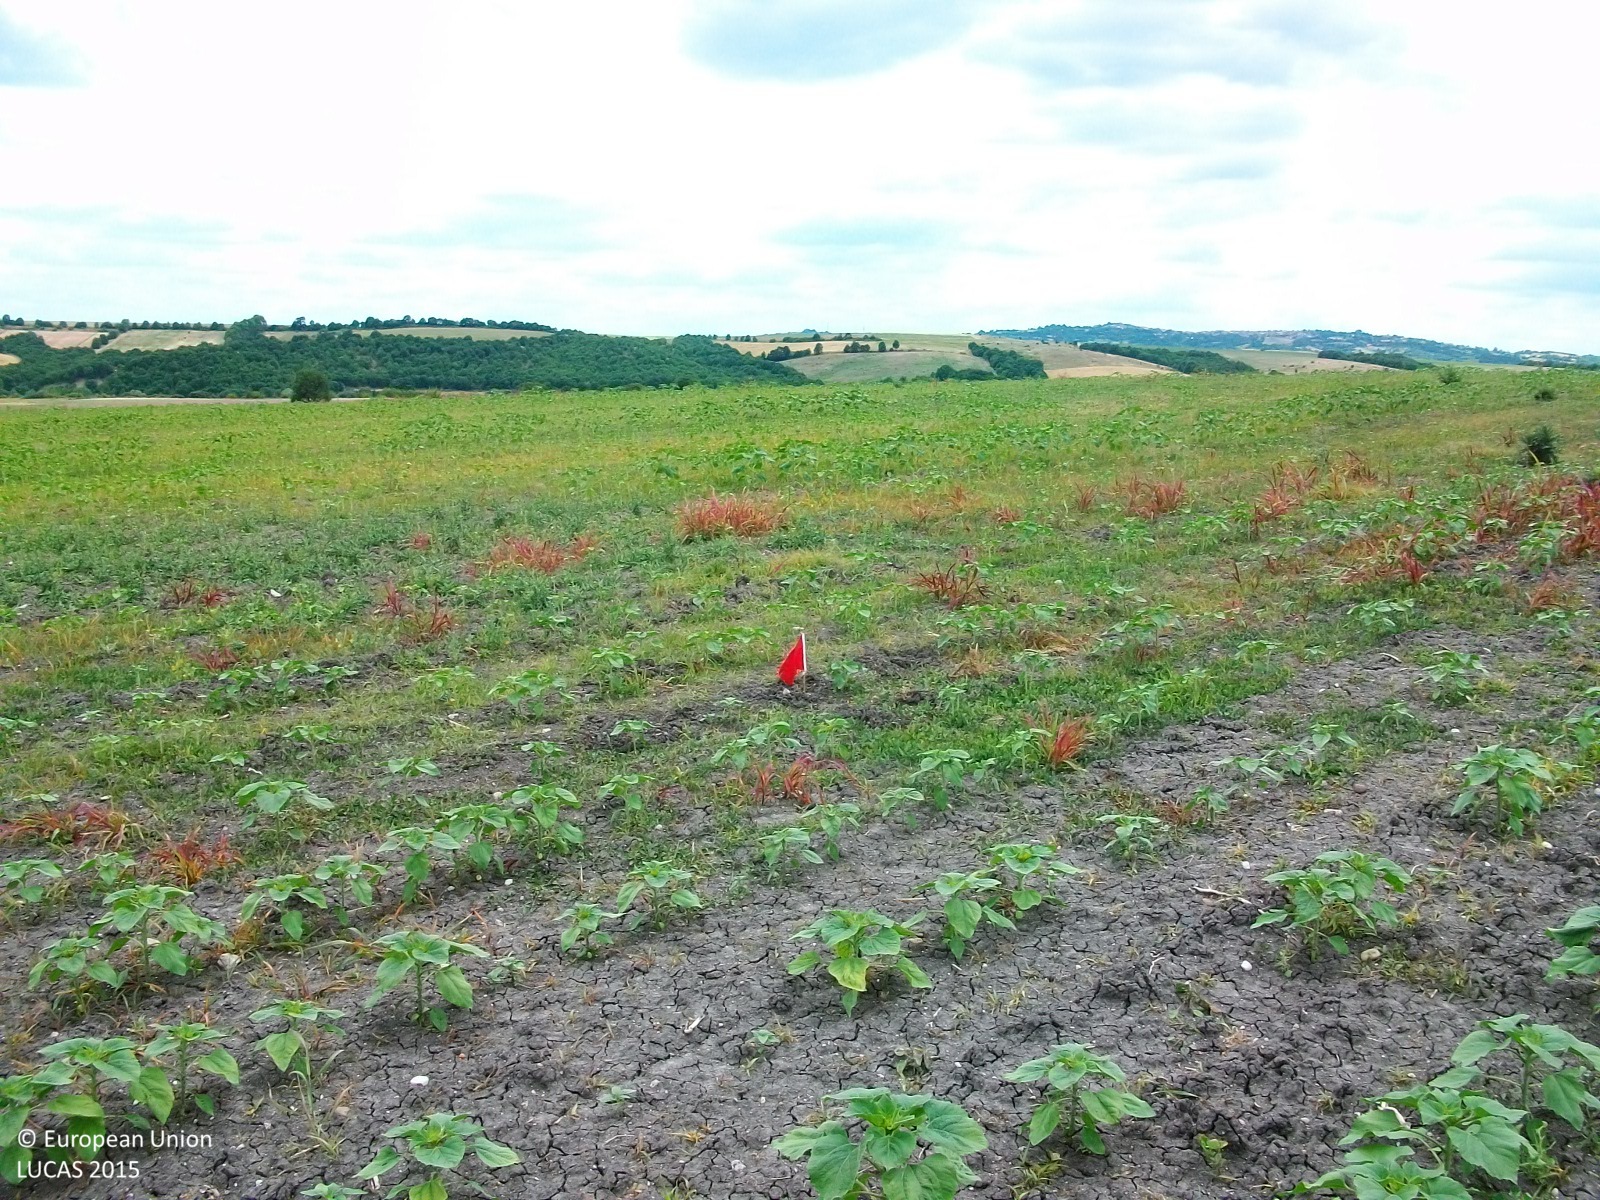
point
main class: Cropland
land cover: Sunflower
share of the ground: < 10 %
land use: Agriculture (excluding fallow land and kitchen gardens)
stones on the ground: < 10 %
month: June
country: GR
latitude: 41.6913
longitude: 26.1864
